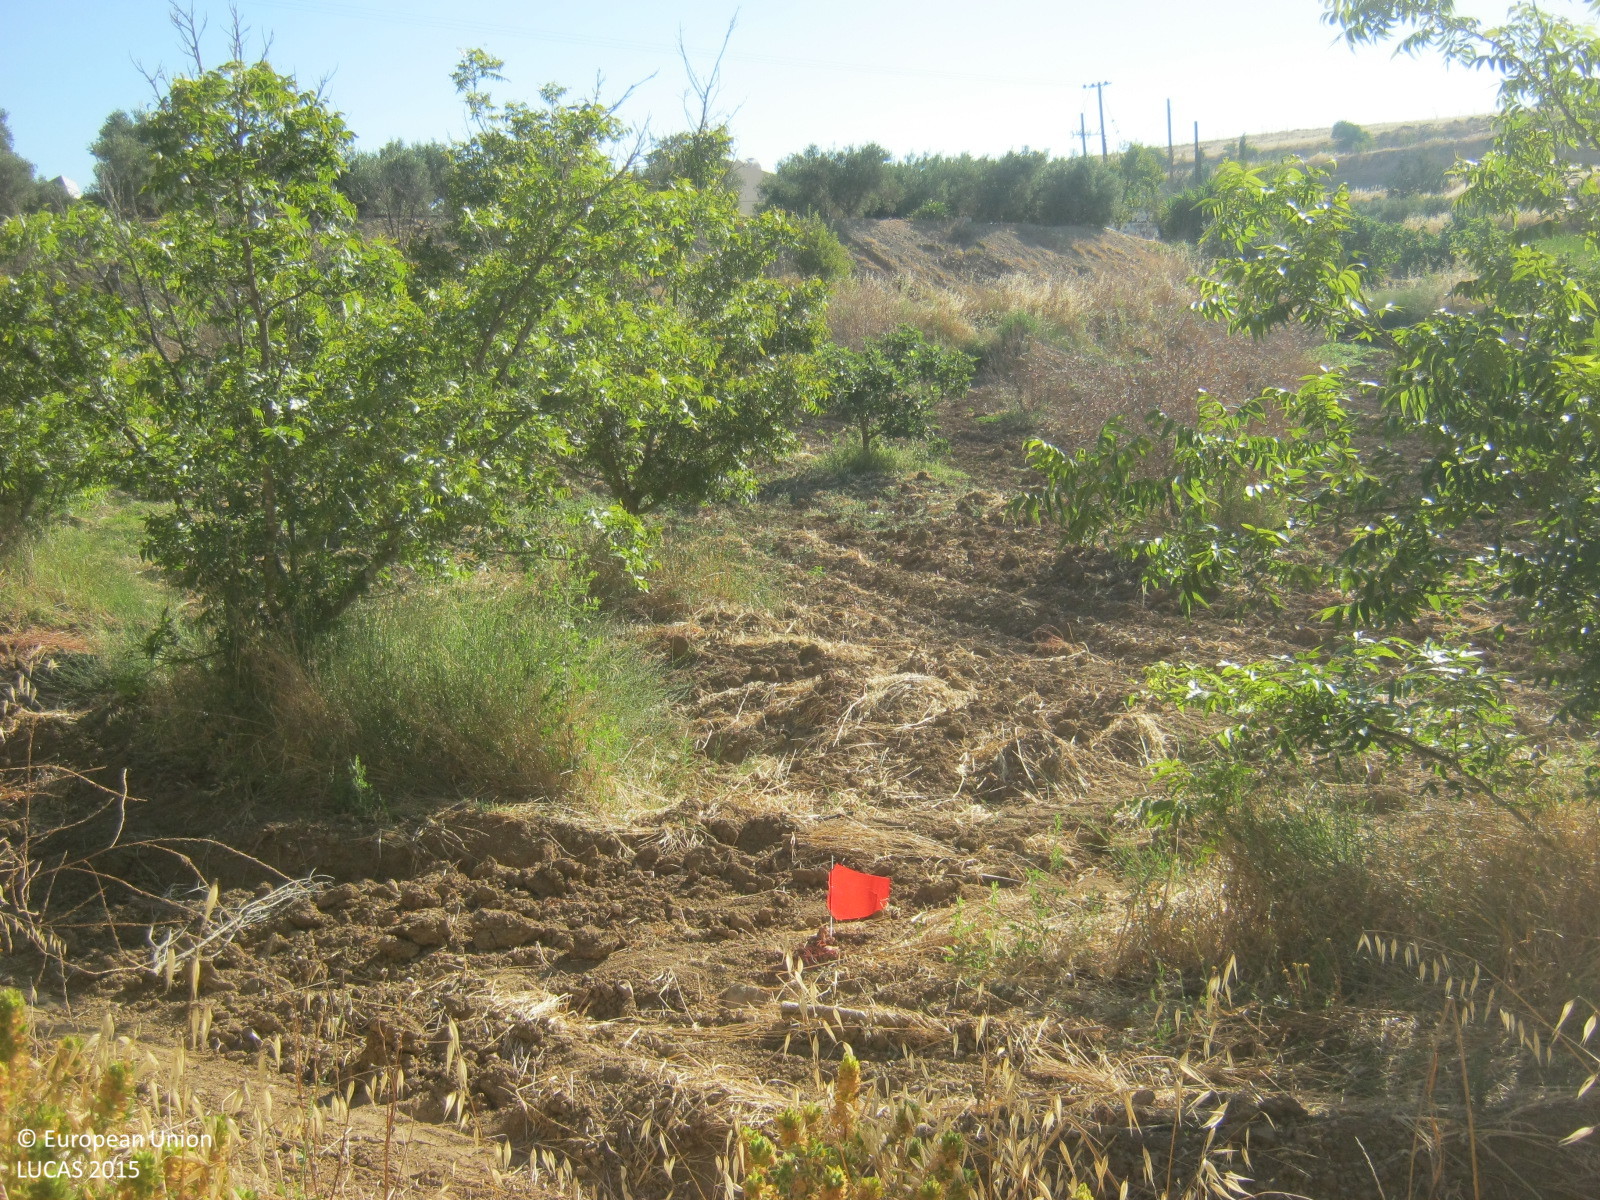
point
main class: Cropland
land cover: Nuts trees
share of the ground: 10 - 25 %
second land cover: Other bare soil
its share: > 75 %
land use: Agriculture (excluding fallow land and kitchen gardens)
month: June
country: CY
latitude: 35.1017
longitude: 33.1896
